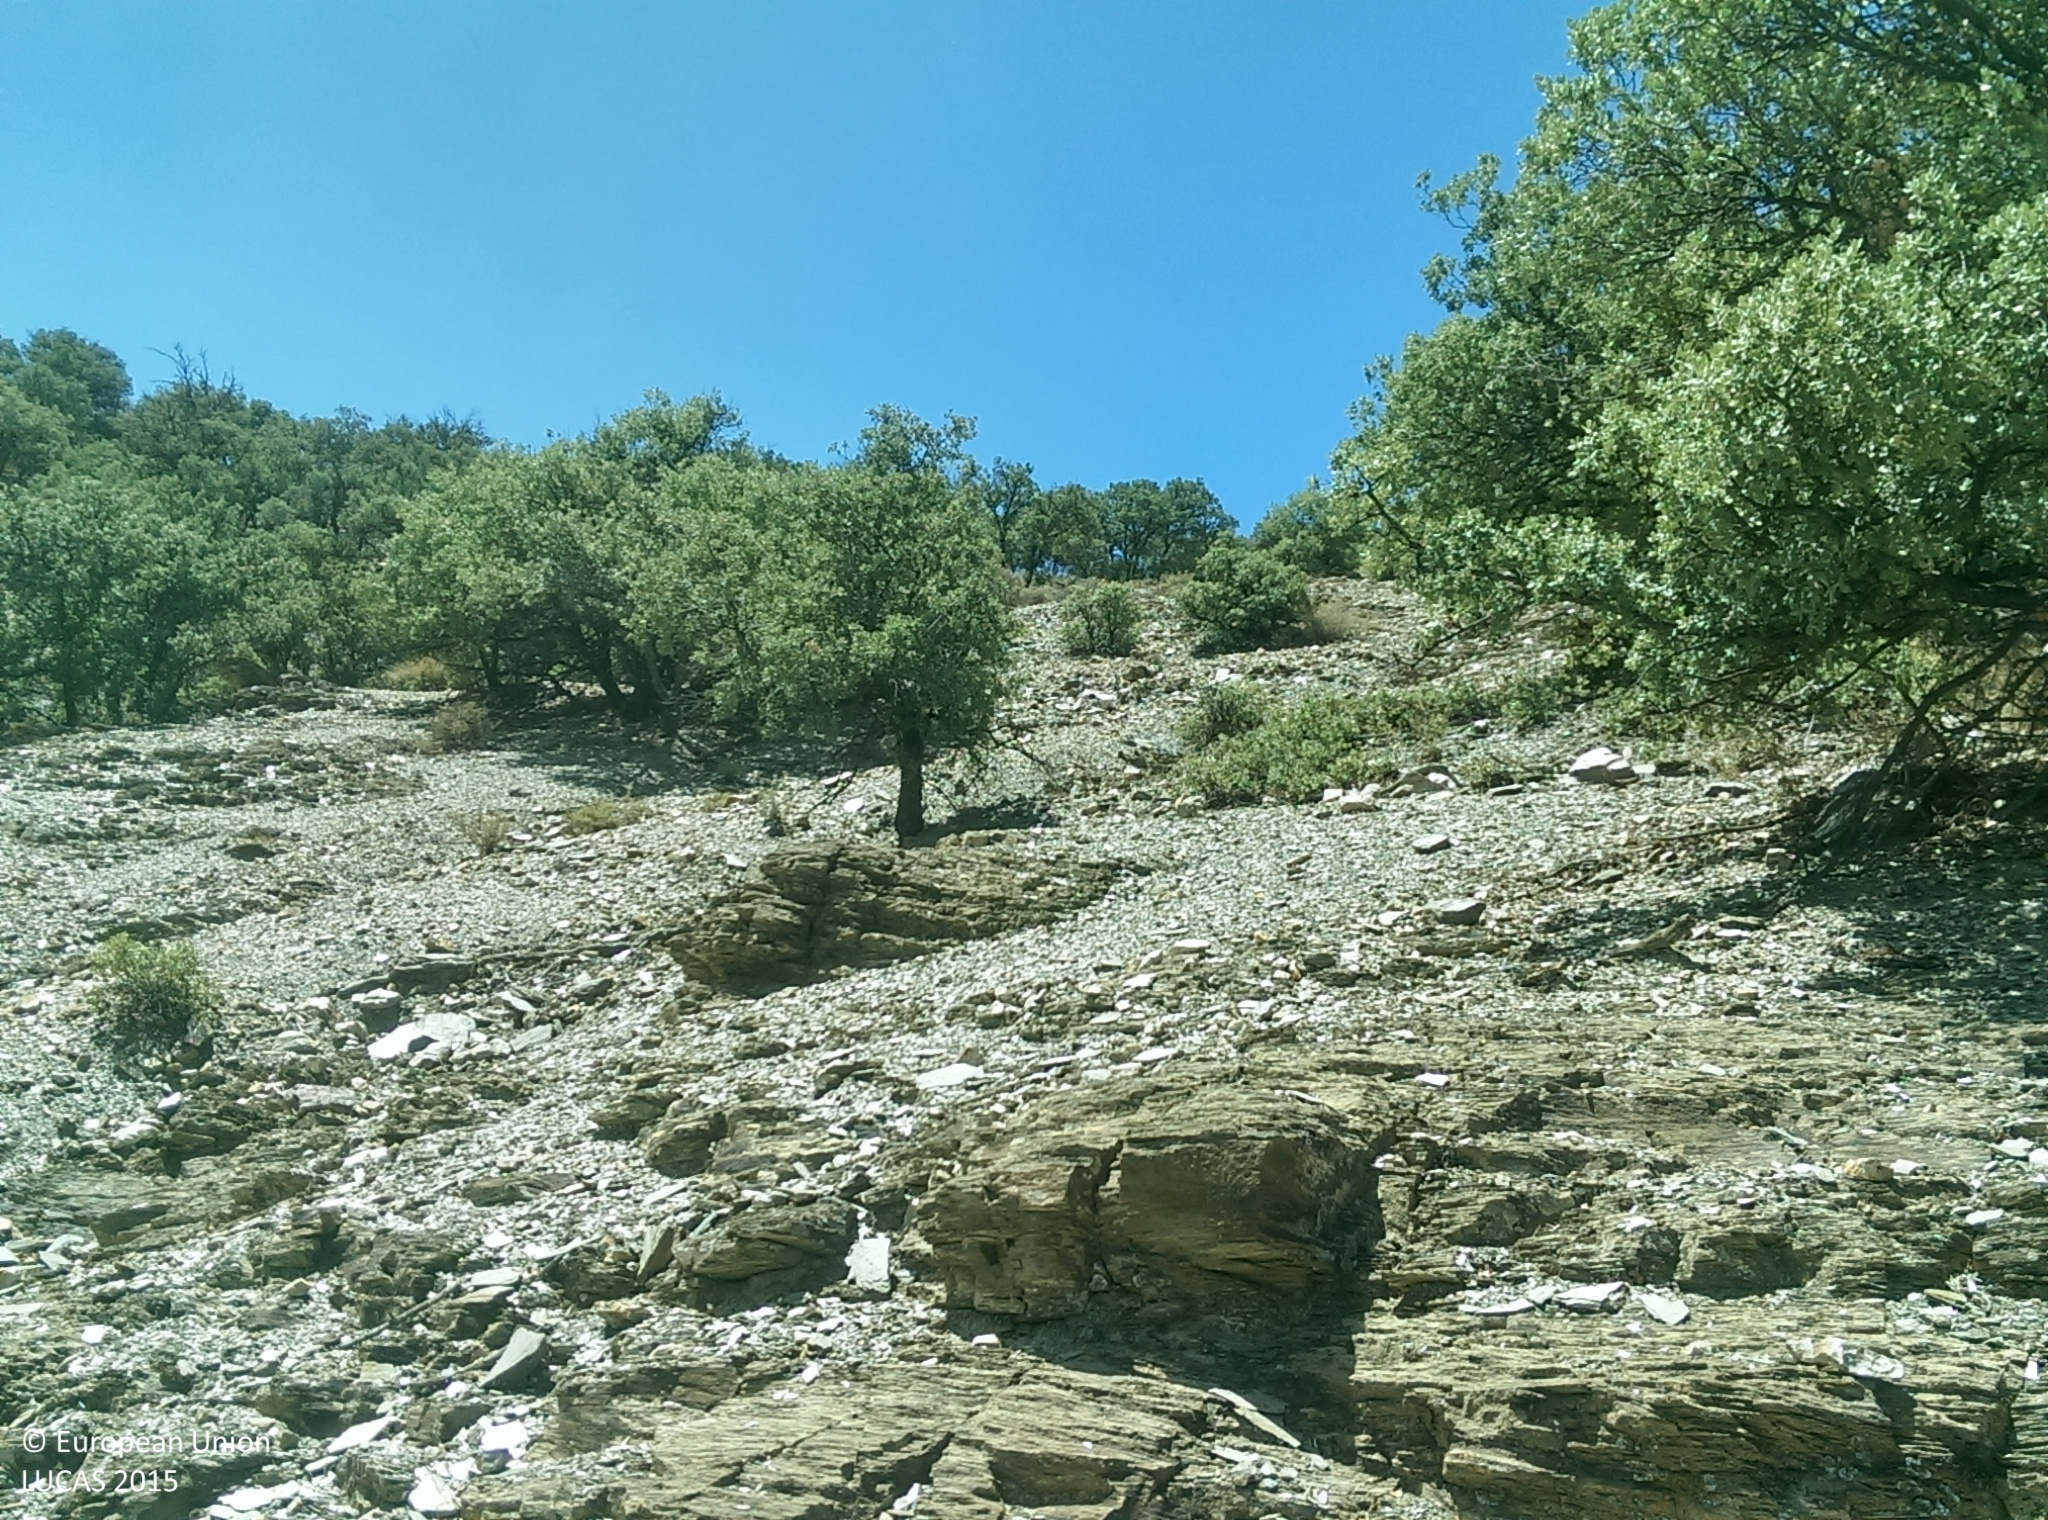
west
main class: Woodland
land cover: Broadleaved woodland
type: broadleaved evergreen forest
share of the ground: 50 - 75 %
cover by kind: broadleaved forest trees 60 %, consolidated bare surface 15 %, shrubs 10 %, unconsolidated bare surface 10 %, herbaceous plants 5 %
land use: Semi-natural and natural areas not in use
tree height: < 5 m
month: July
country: ES
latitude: 37.1519
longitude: -3.0791
